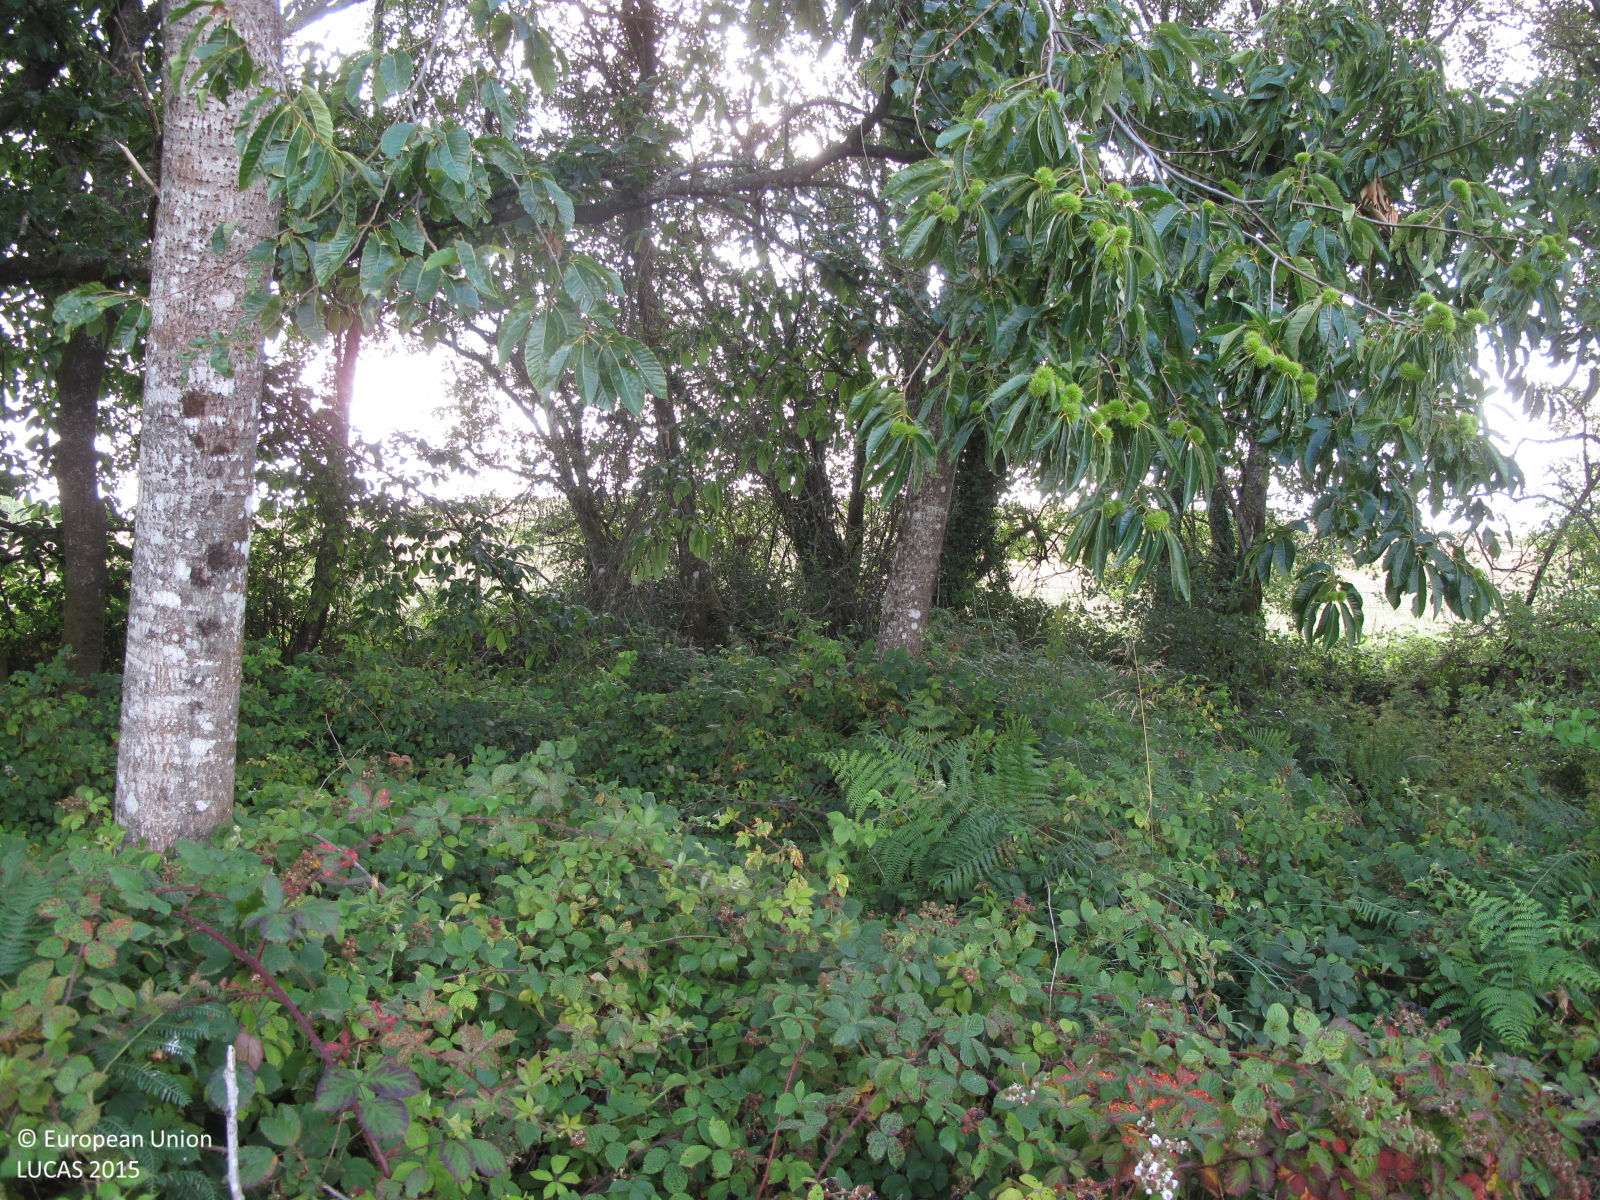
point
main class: Woodland
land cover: Broadleaved woodland
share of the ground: > 75 %
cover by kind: broadleaved forest trees 90 %, shrubs 10 %
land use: Semi-natural and natural areas not in use
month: July
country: ES
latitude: 43.1159
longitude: -7.9722
